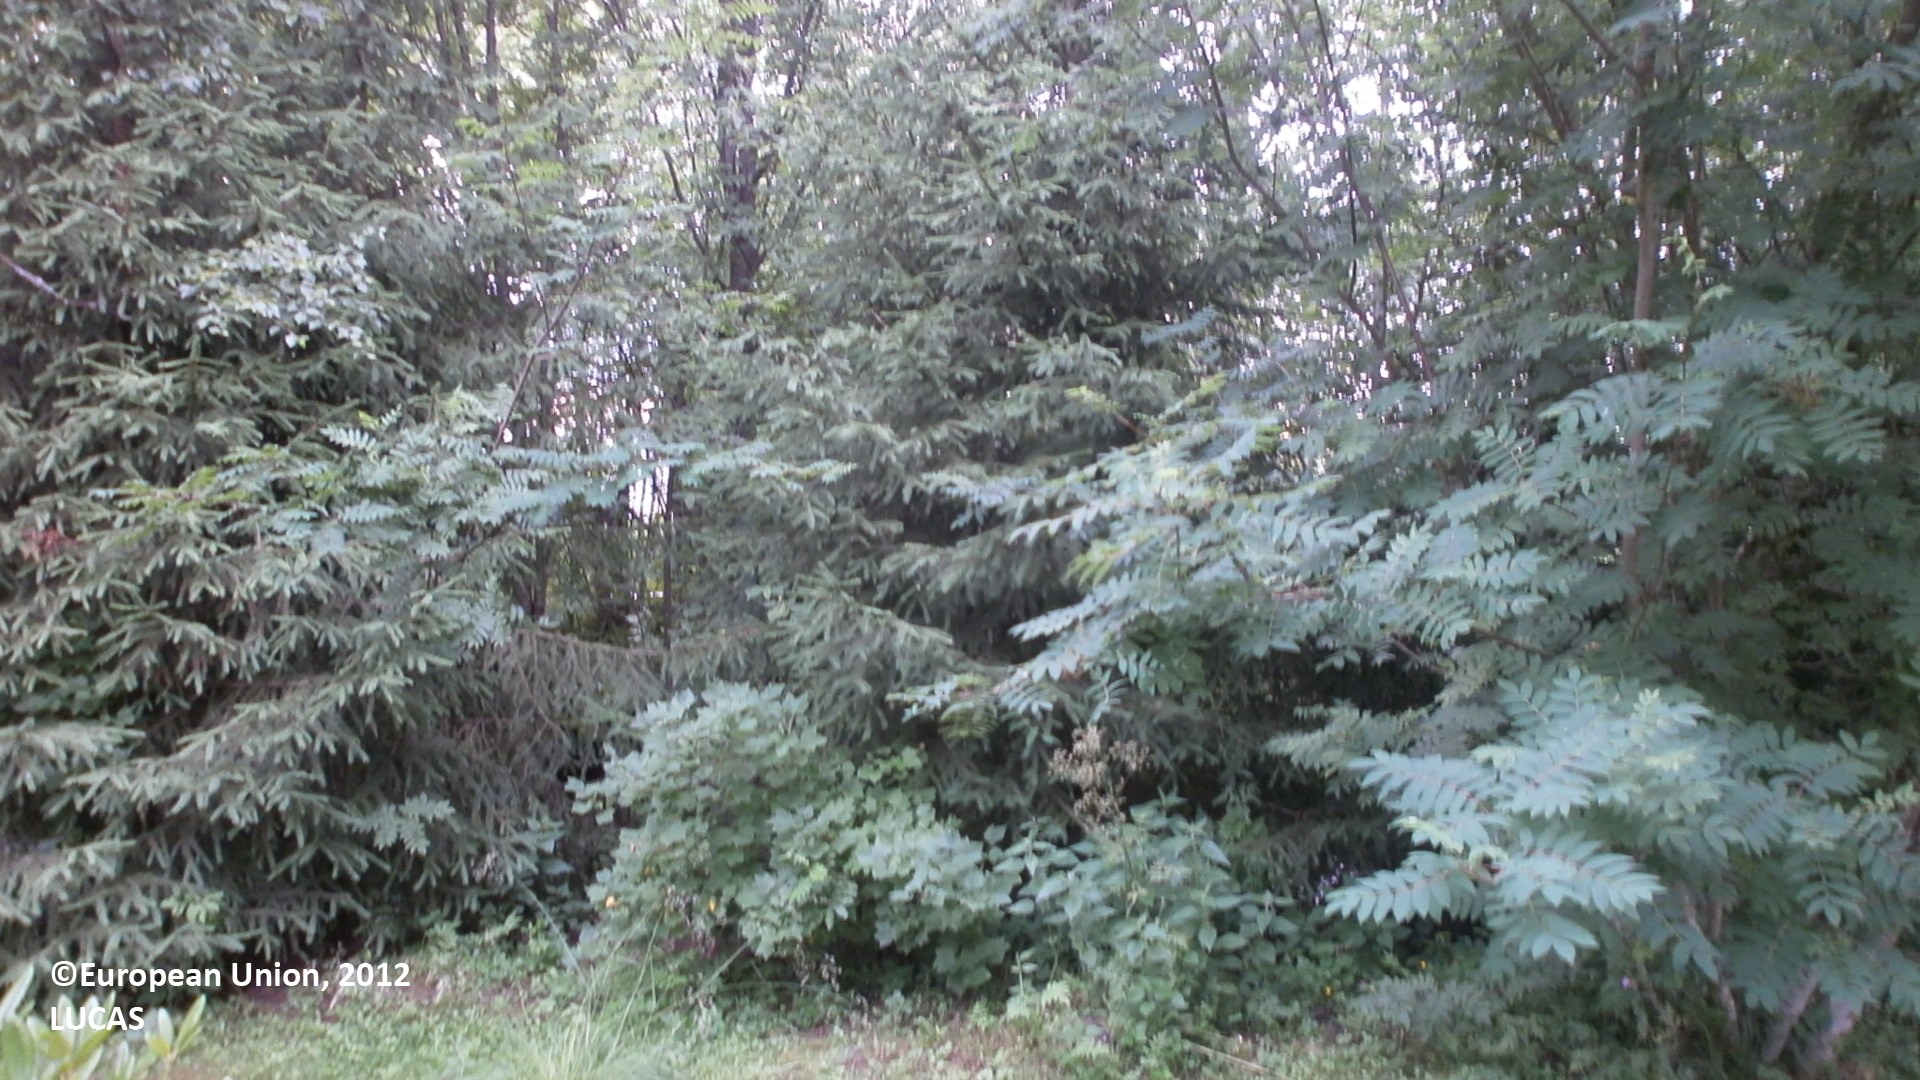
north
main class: Grassland
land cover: Grassland with sparse tree/shrub cover
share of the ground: > 75 %
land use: Residential
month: July
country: FI
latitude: 64.6777
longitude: 24.5904
